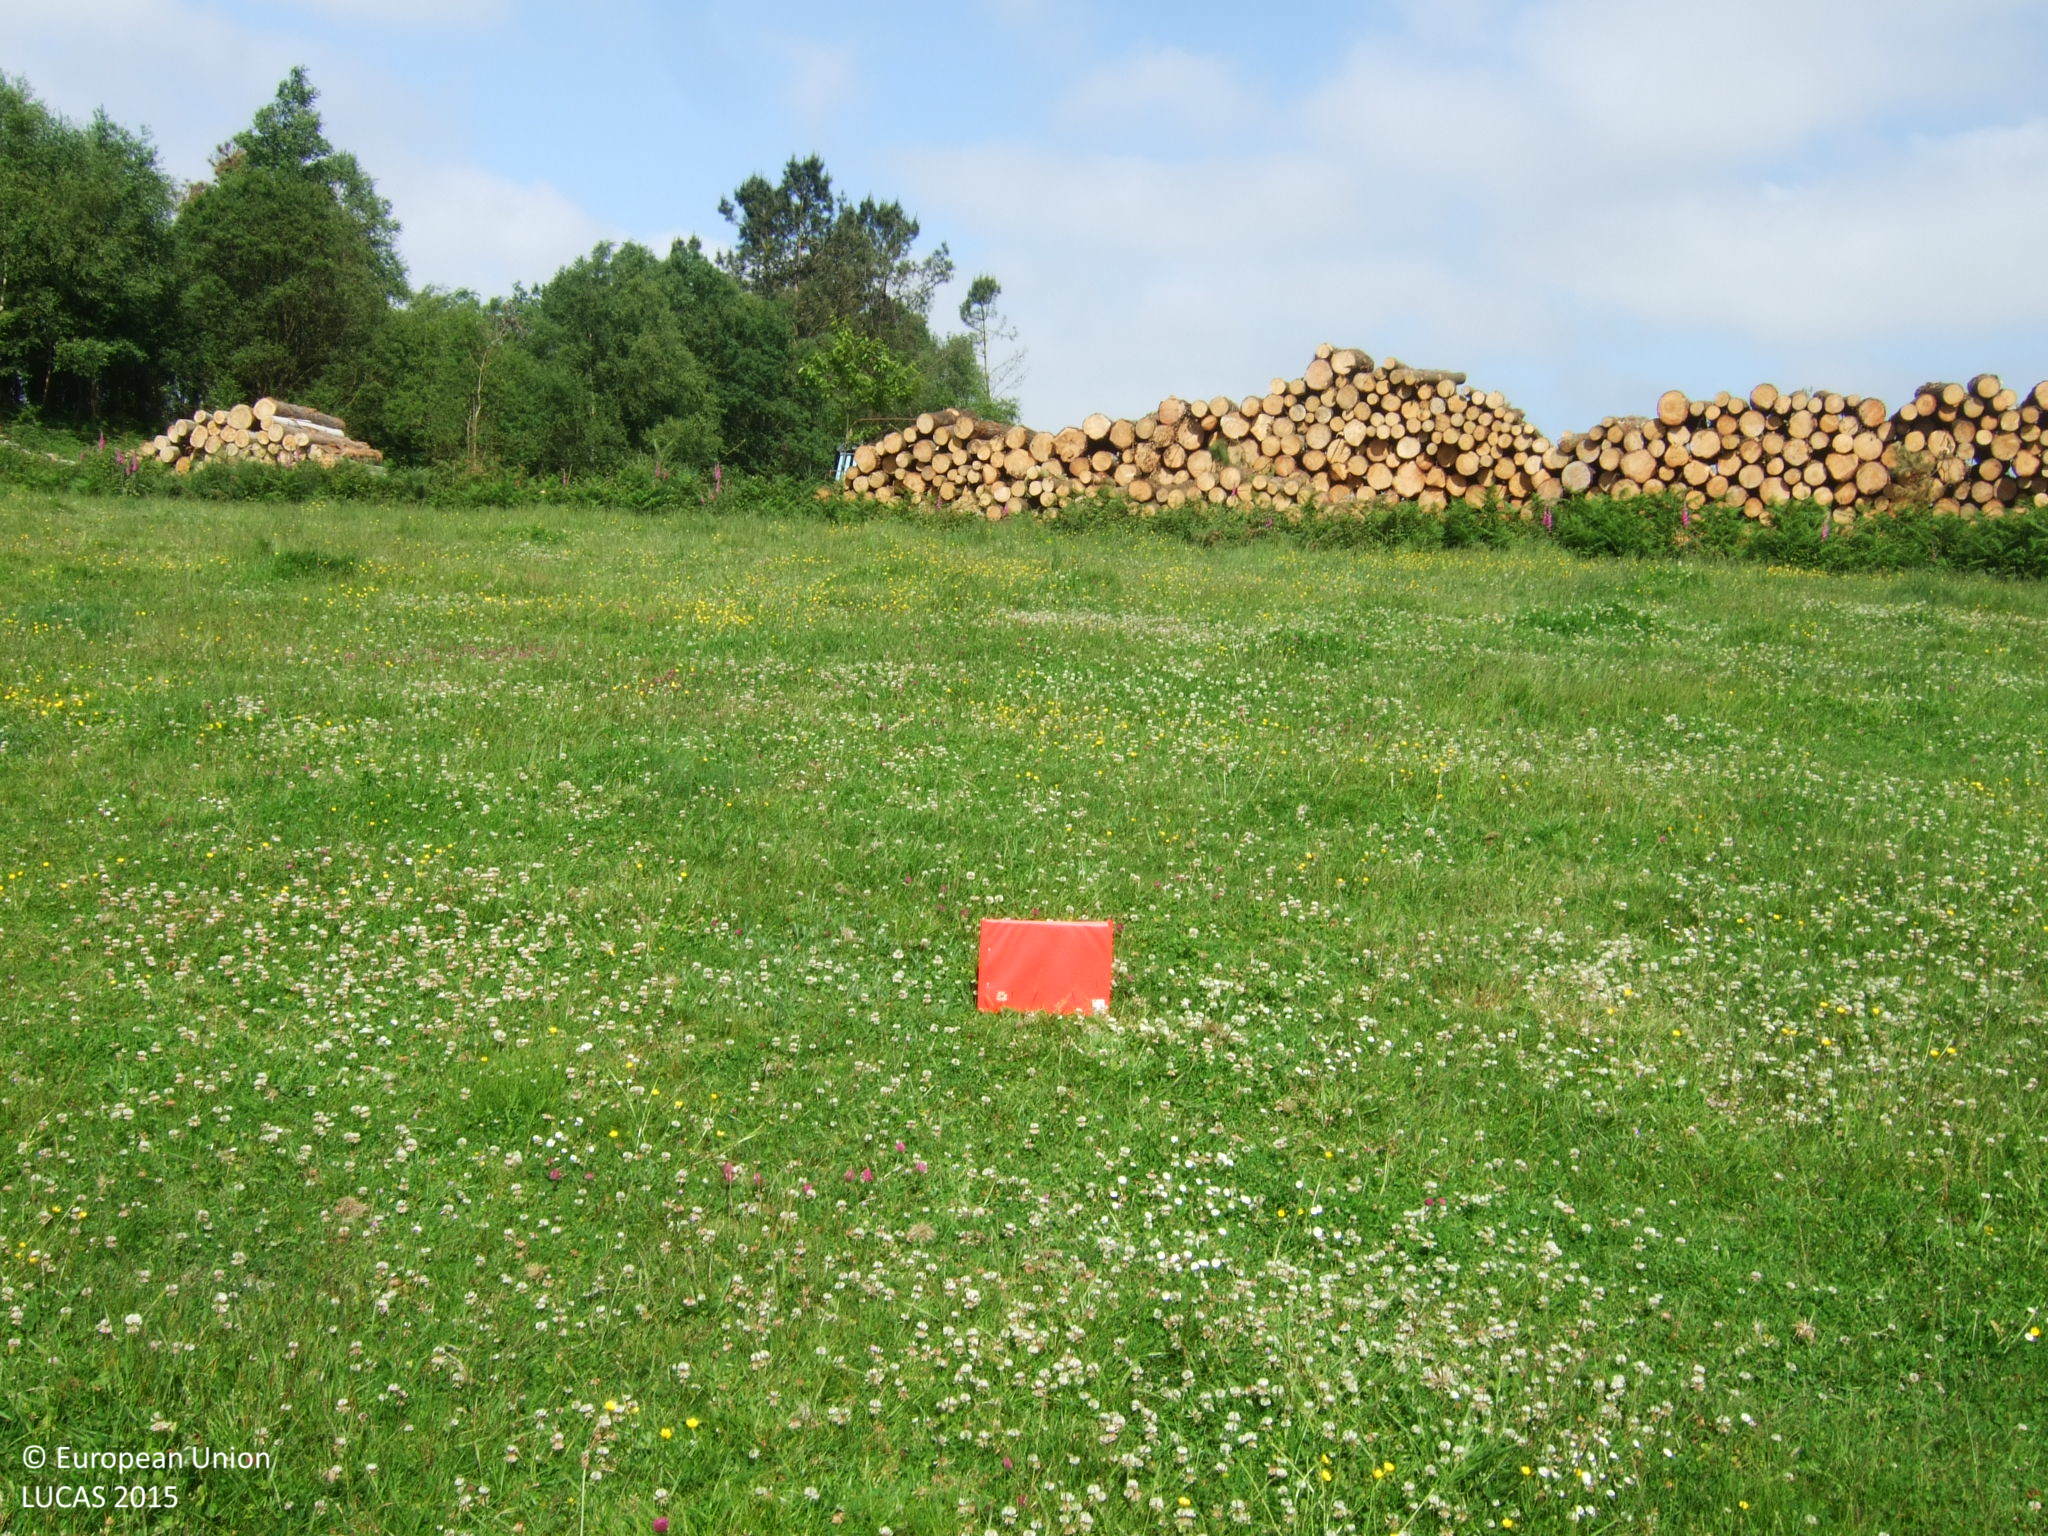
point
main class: Grassland
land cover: Grassland without tree/shrub cover
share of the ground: > 75 %
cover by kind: herbaceous plants 100 %
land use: Agriculture (excluding fallow land and kitchen gardens)
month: June
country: ES
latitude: 43.2873
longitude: -7.4170
